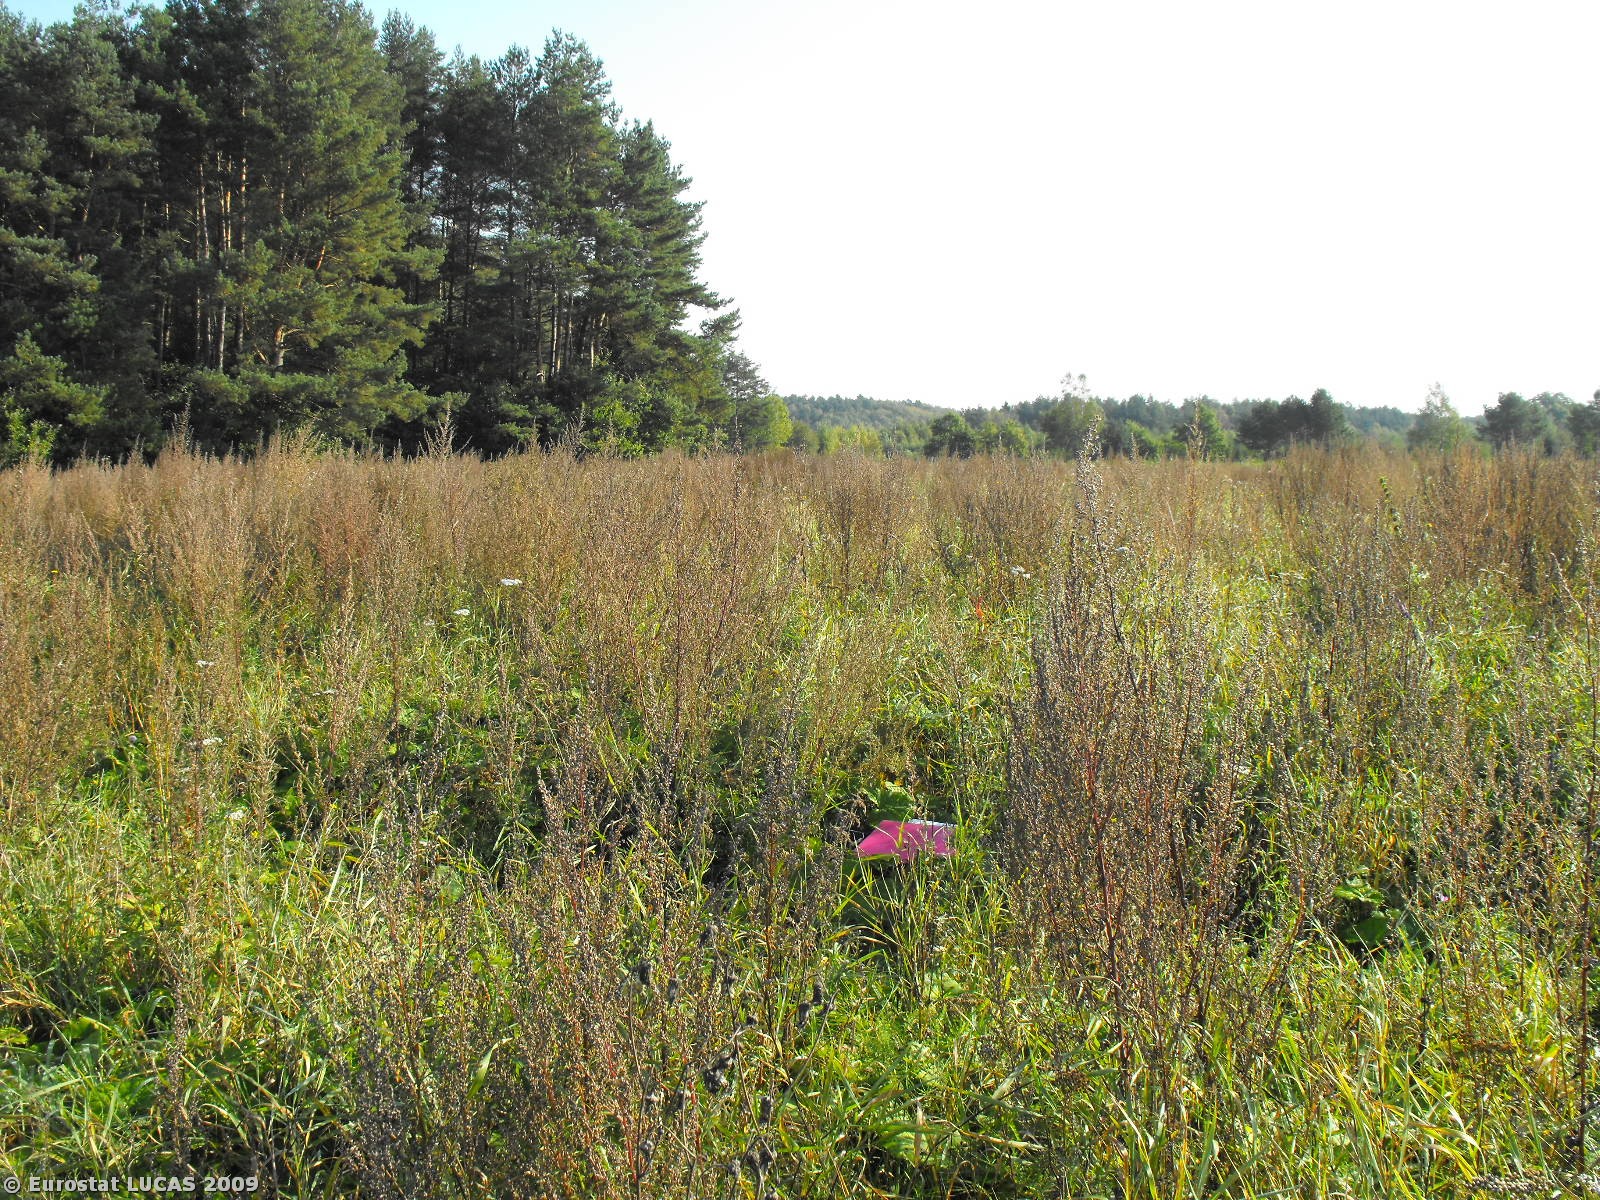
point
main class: Grassland
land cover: Spontaneously vegetated surfaces
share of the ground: > 75 %
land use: Unused
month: September
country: PL
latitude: 54.4456
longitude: 16.6528
